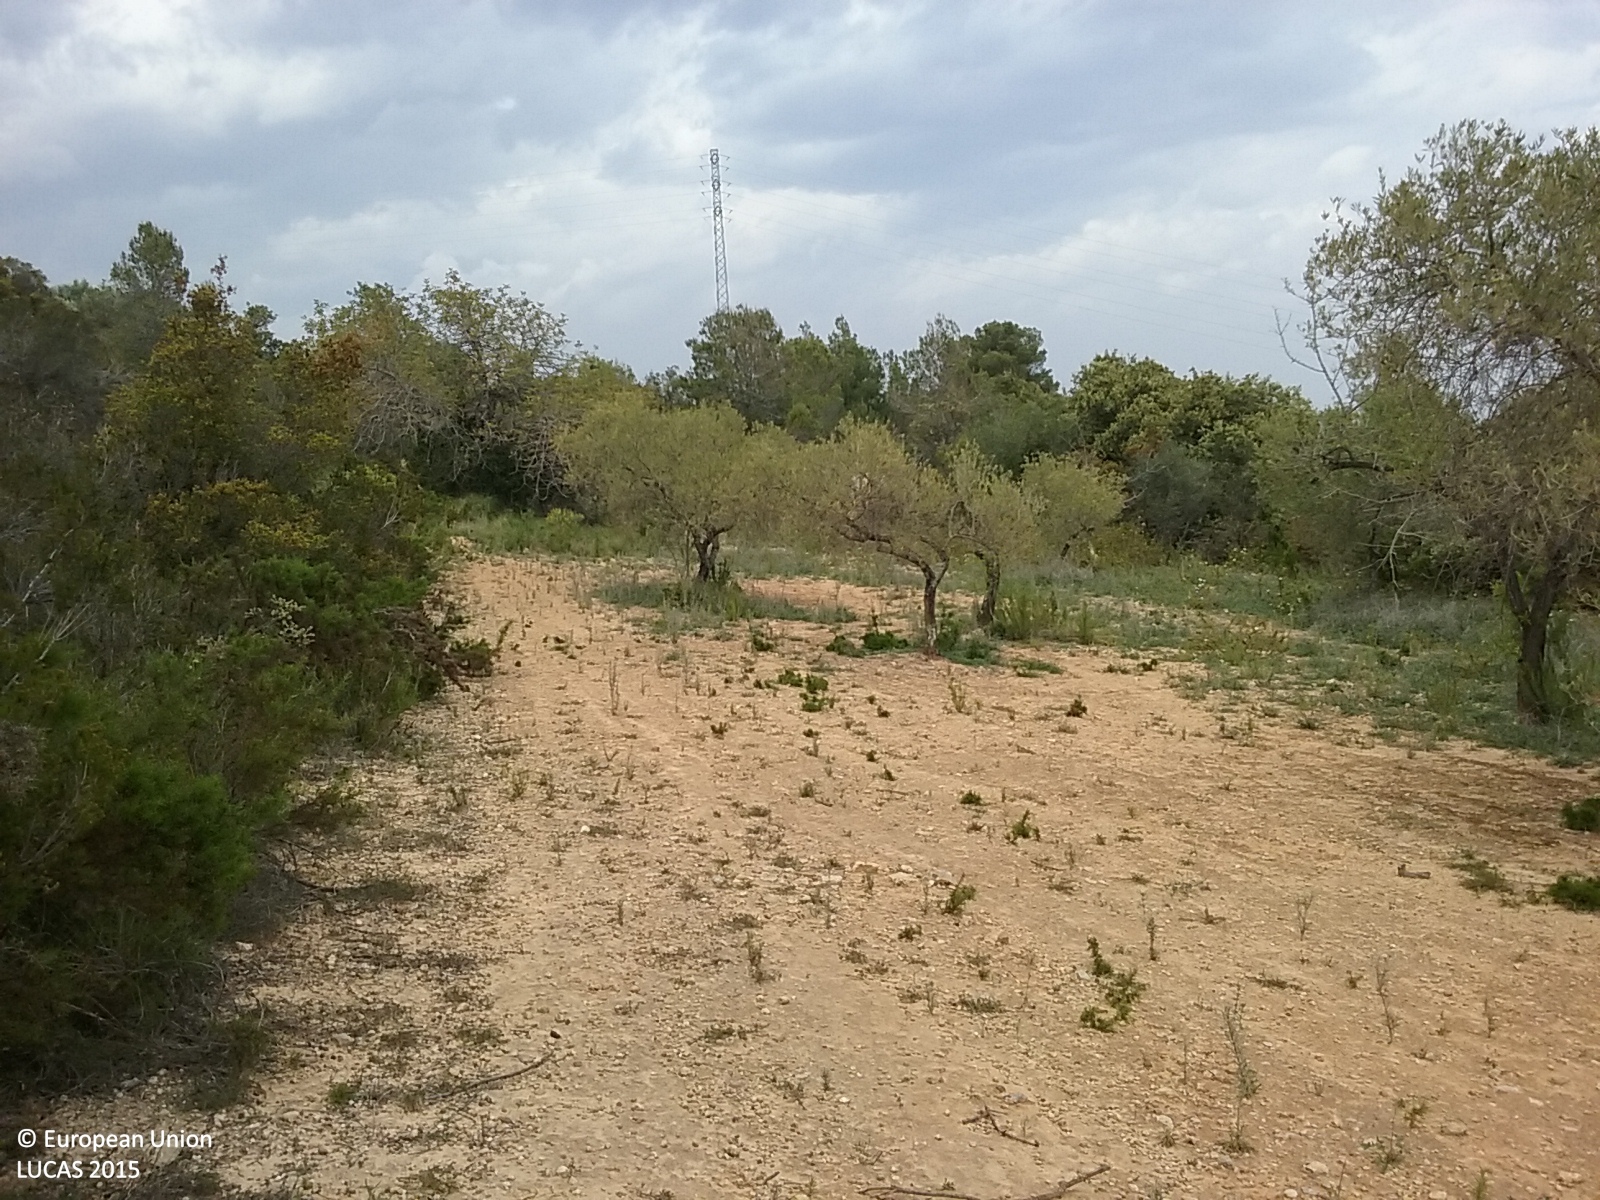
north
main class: Woodland
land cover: Broadleaved woodland
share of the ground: 10 - 25 %
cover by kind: shrubs 70 %, broadleaved forest trees 25 %, coniferous forest trees 5 %
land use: Semi-natural and natural areas not in use
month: April
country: ES
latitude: 40.5145
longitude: 0.3058
